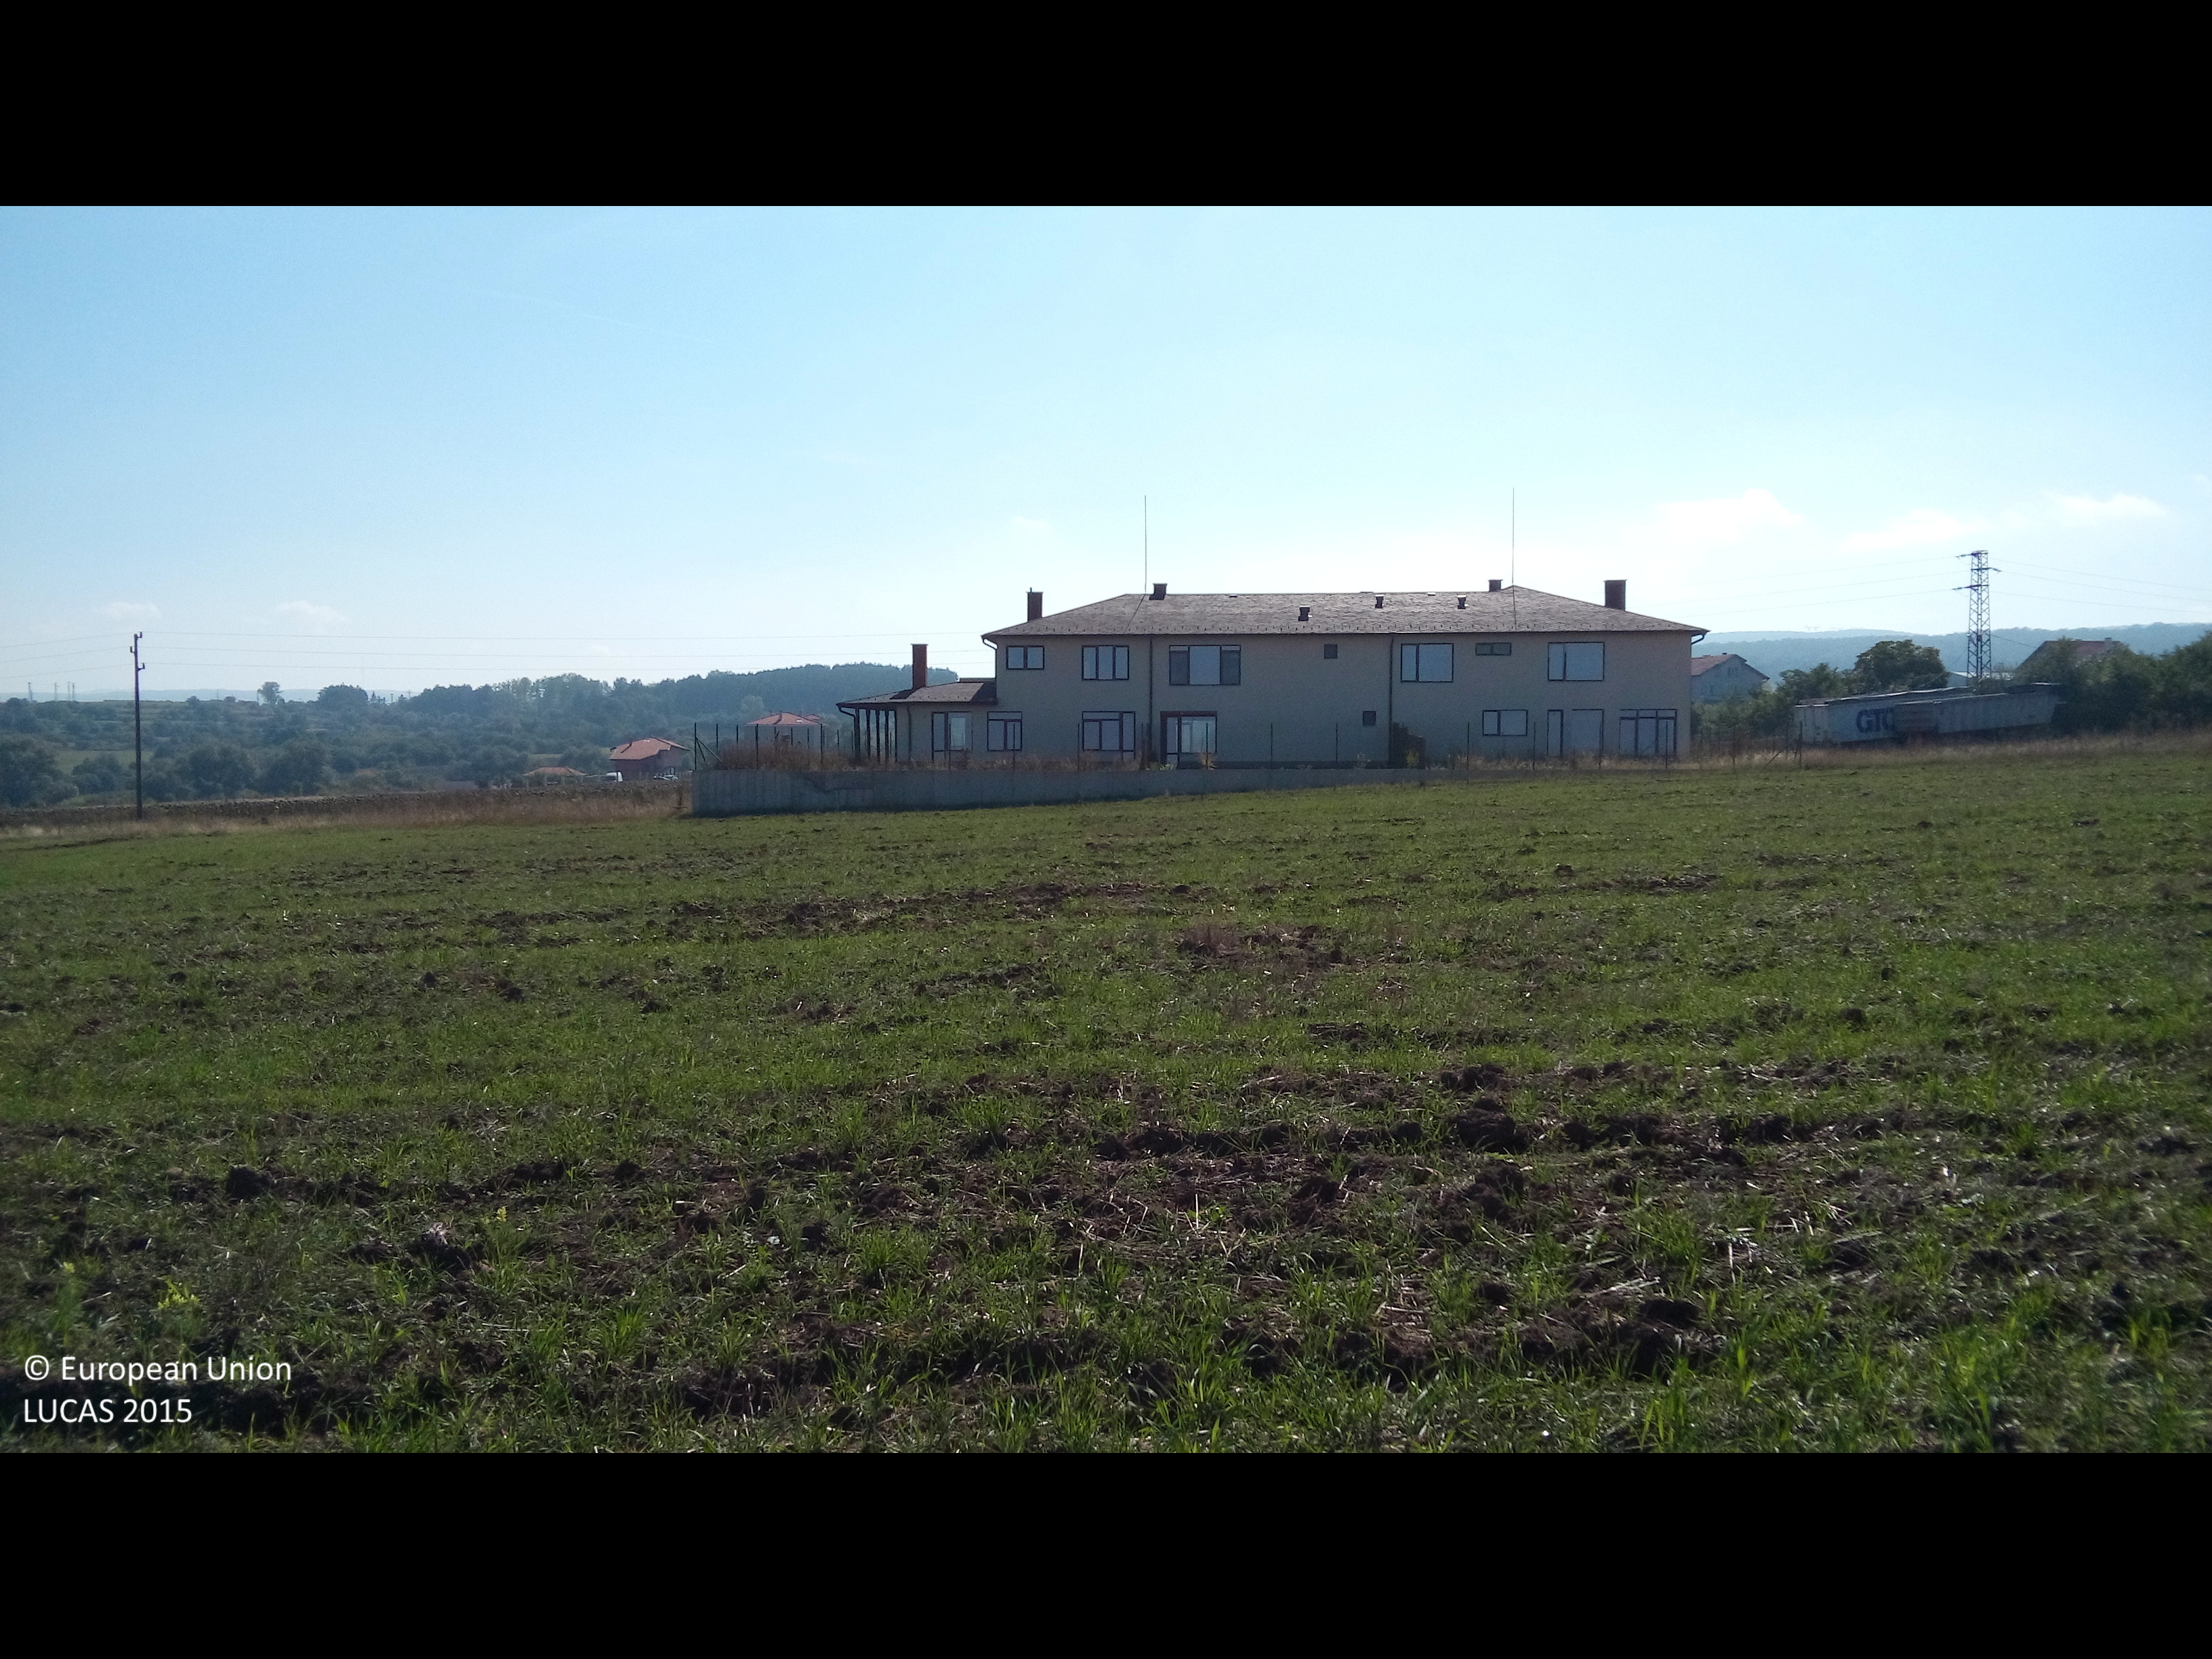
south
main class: Cropland
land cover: Common wheat
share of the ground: < 10 %
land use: Agriculture (excluding fallow land and kitchen gardens)
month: October
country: BG
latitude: 42.6090
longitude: 23.6047
